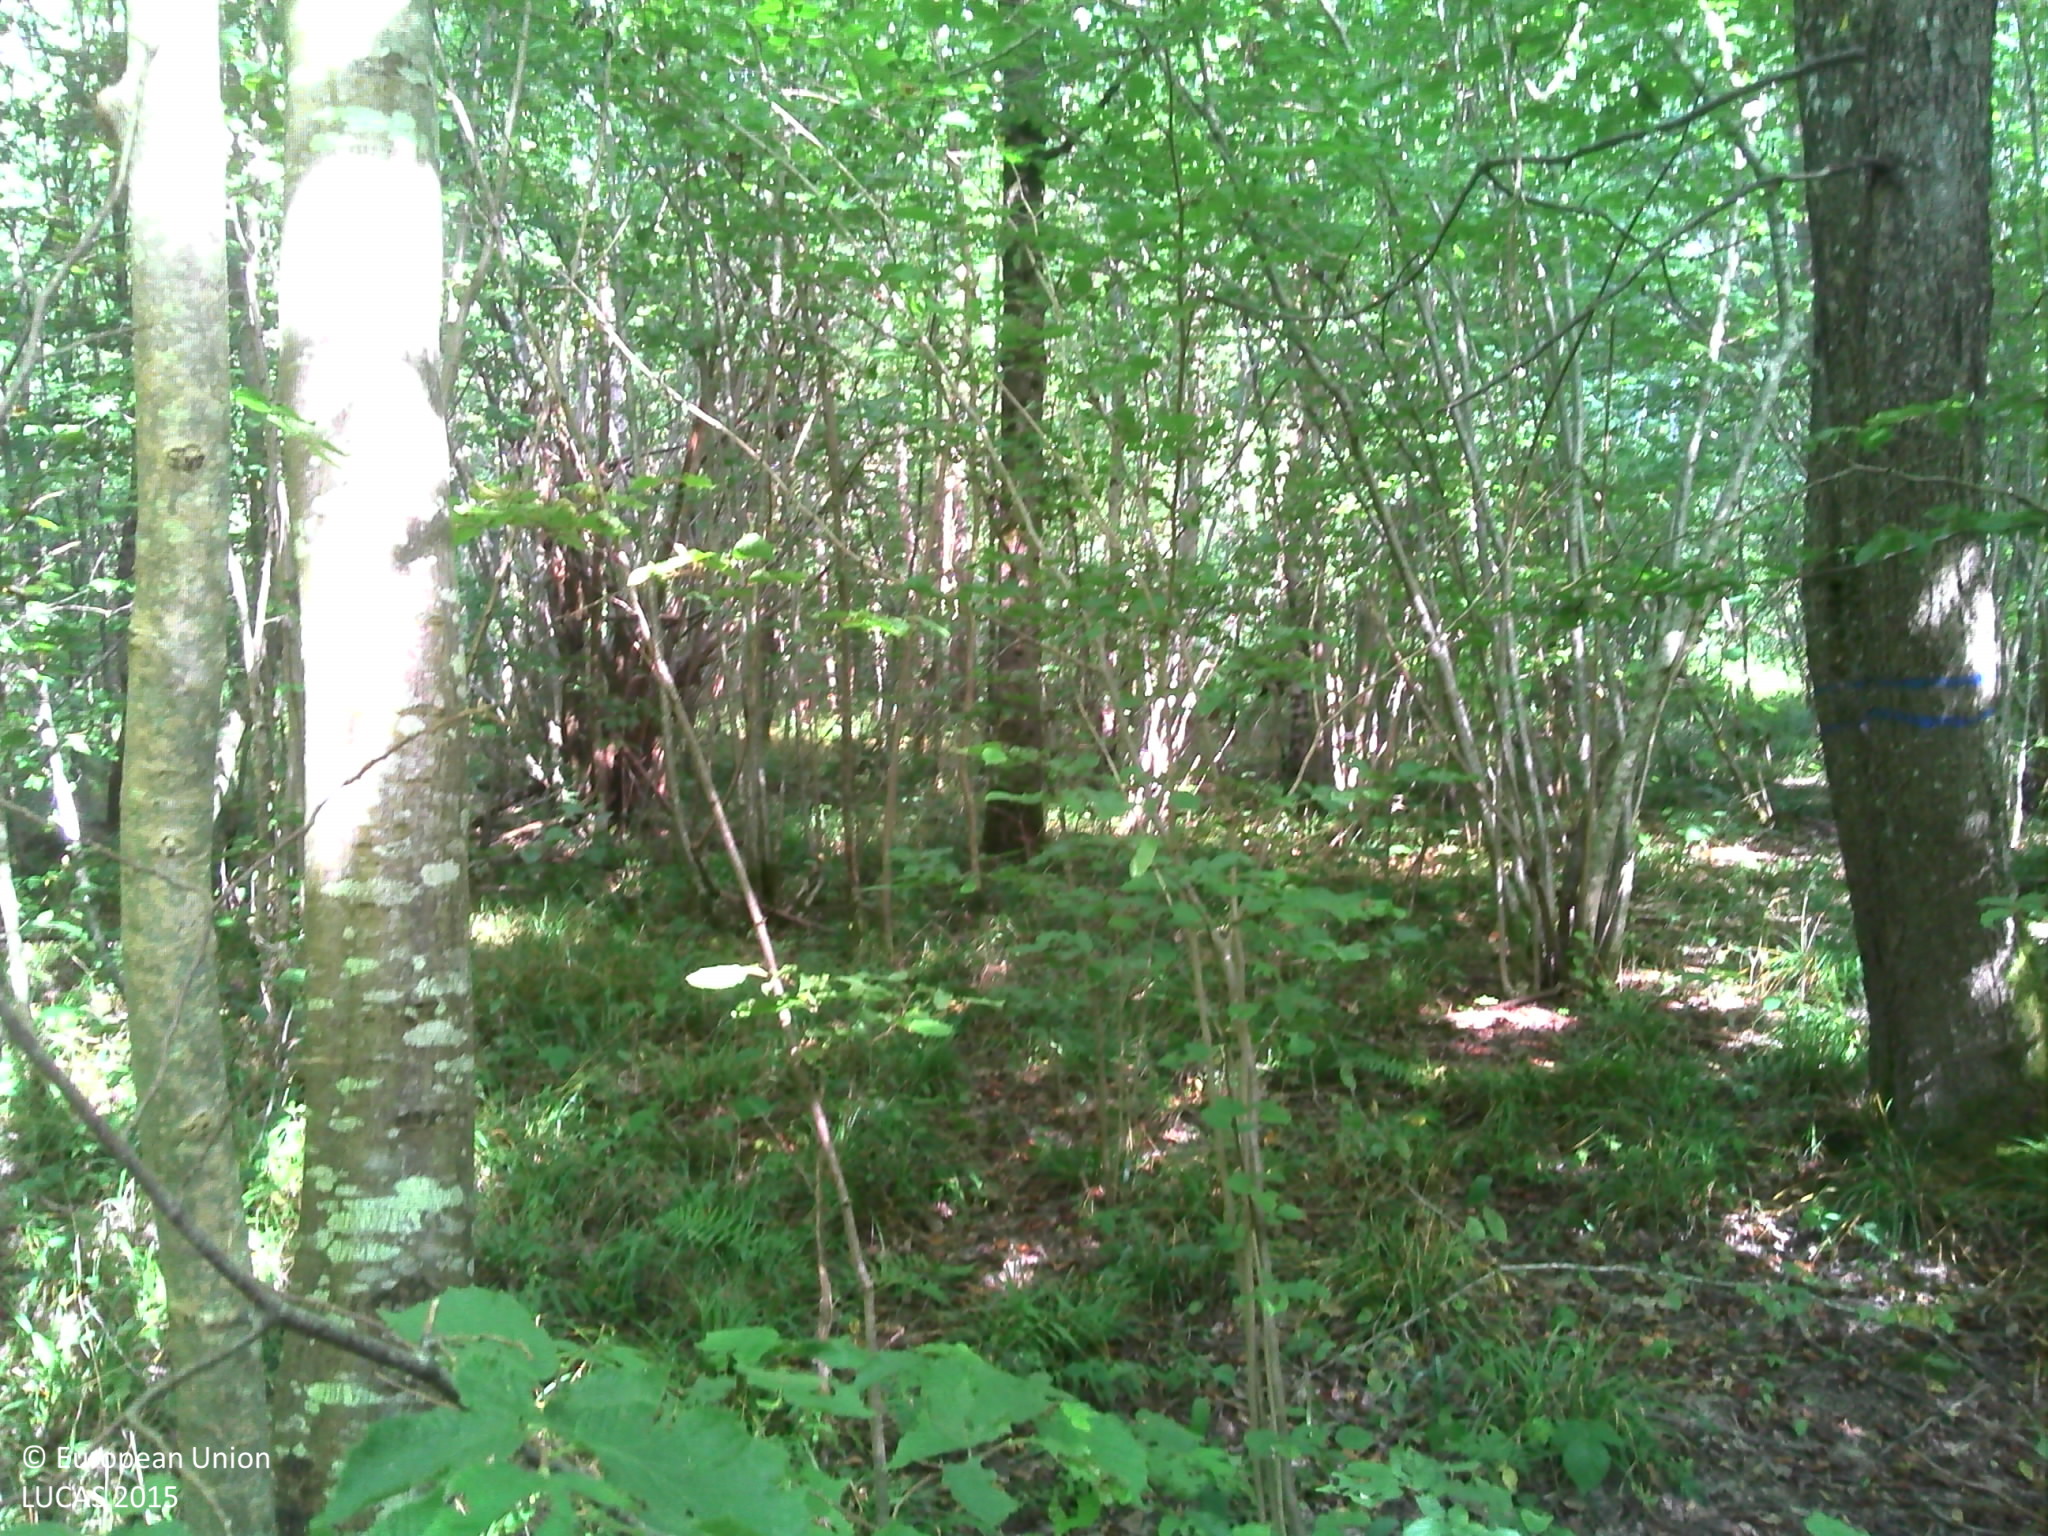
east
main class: Woodland
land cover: Broadleaved woodland
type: mesophytic deciduous forest
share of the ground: > 75 %
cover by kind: broadleaved forest trees 50 %, herbaceous plants 15 %, lichens and mosses 15 %, unconsolidated bare surface 10 %
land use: Forestry
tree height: > 5 m
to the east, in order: Broadleaved woodland; Tracks; Broadleaved woodland; Tracks; Broadleaved woodland
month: July
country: FR
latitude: 48.7769
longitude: 2.7097
